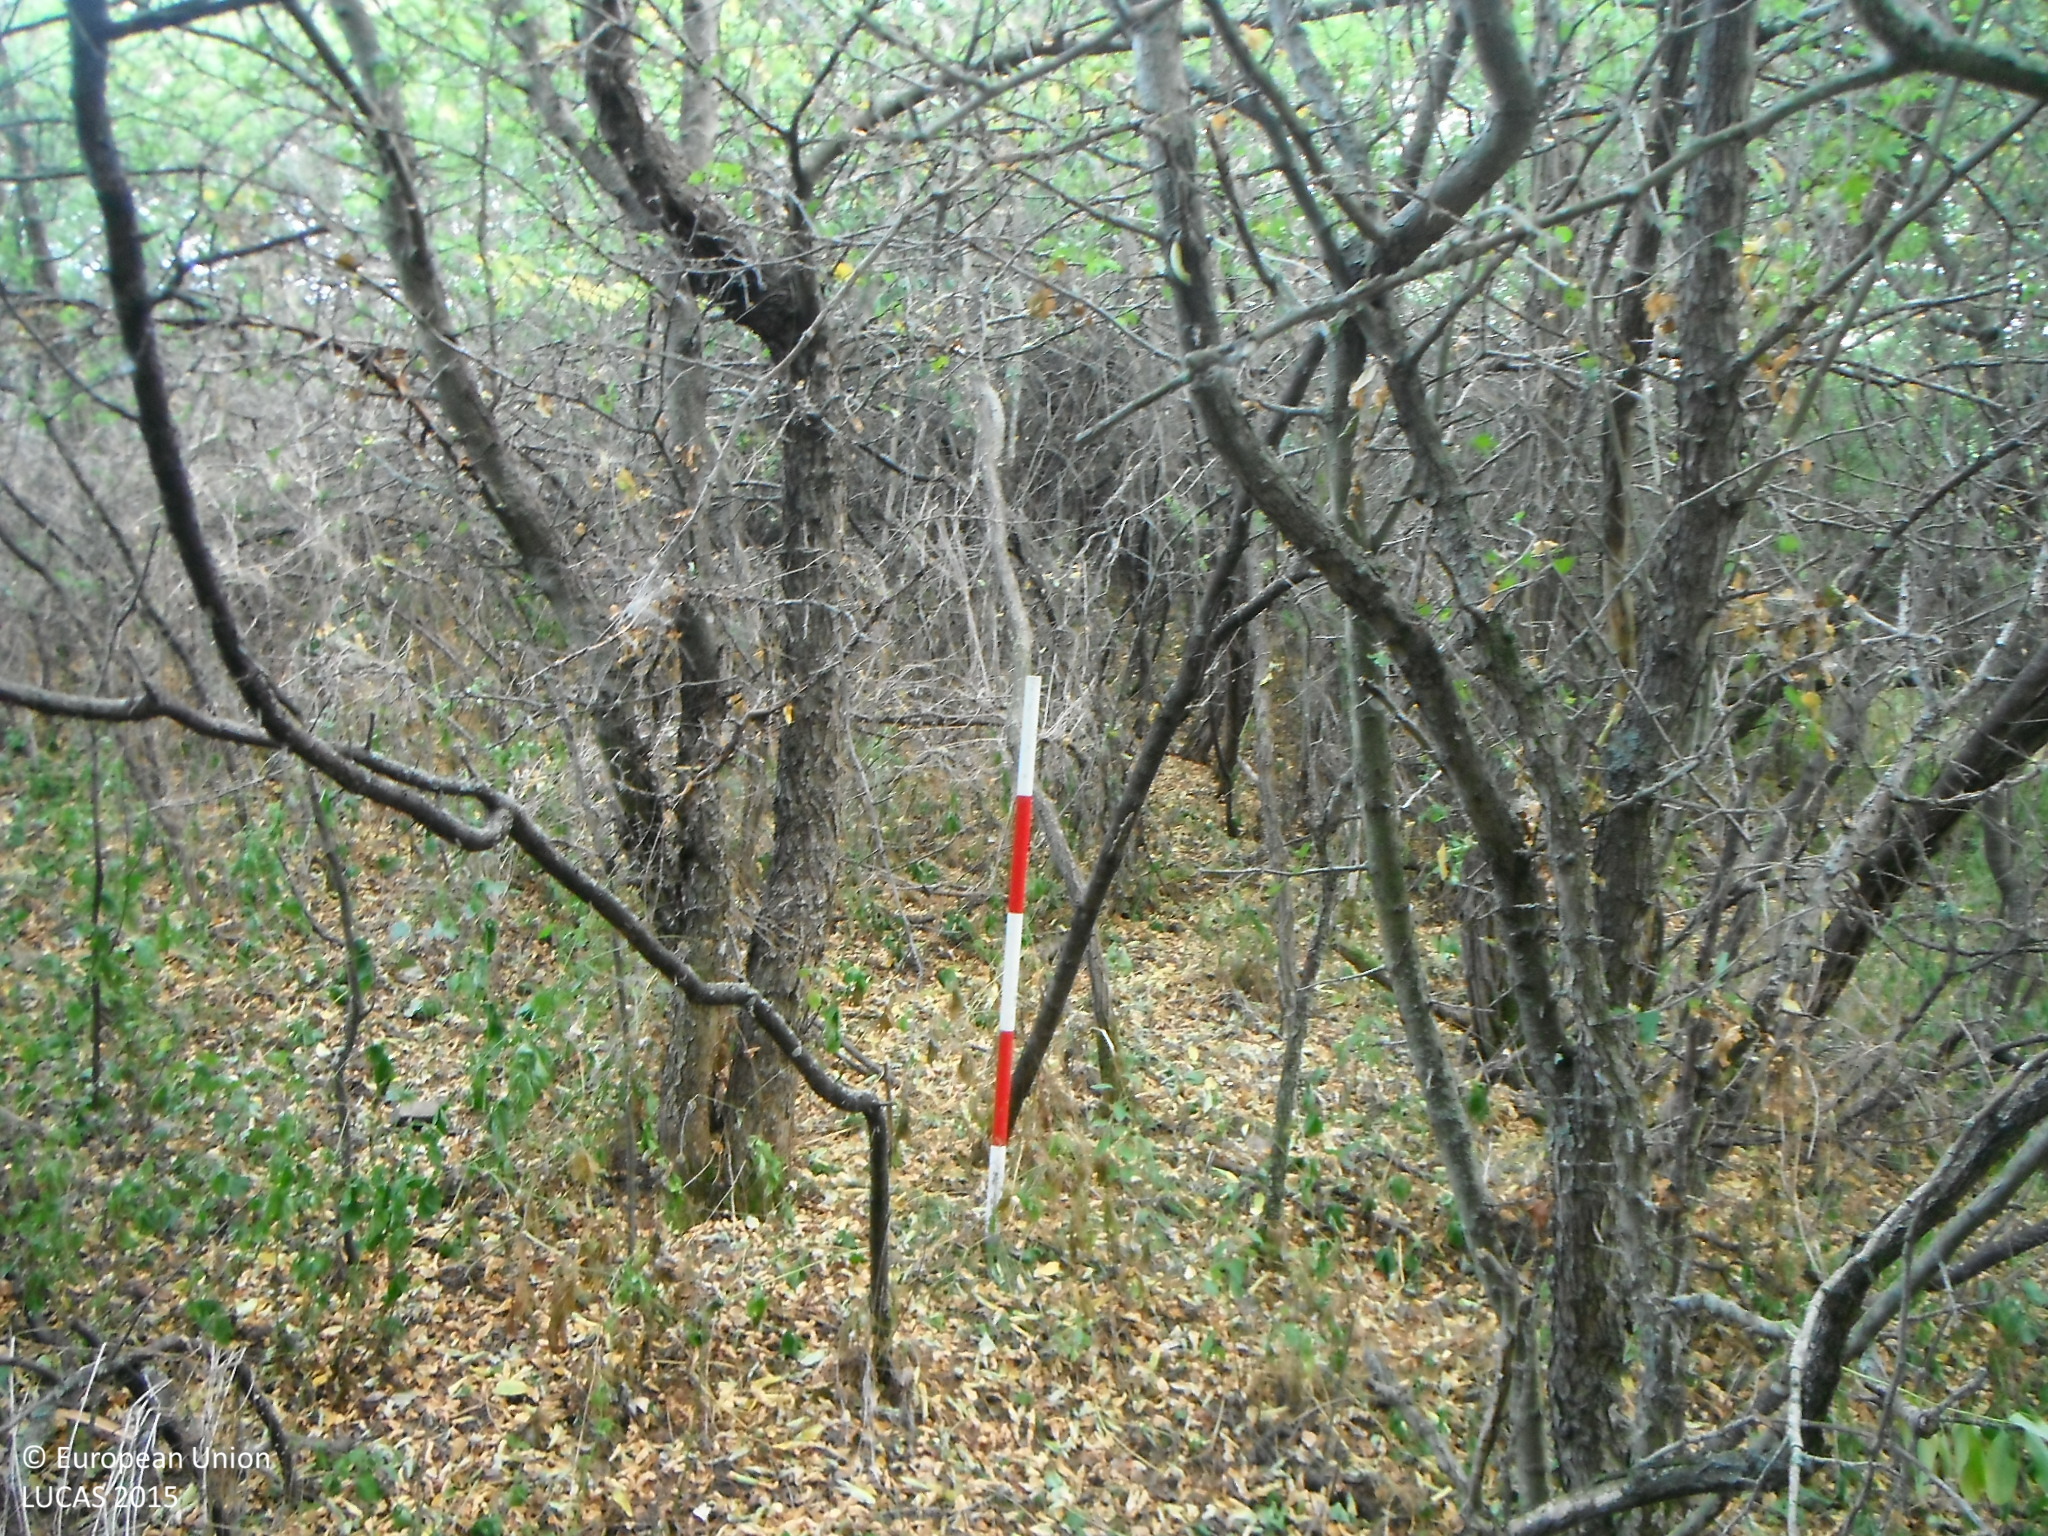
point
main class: Woodland
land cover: Broadleaved woodland
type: mesophytic deciduous forest
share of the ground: > 75 %
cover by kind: broadleaved forest trees 100 %
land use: Semi-natural and natural areas not in use
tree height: > 5 m
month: July
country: SK
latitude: 48.2640
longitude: 19.0869
